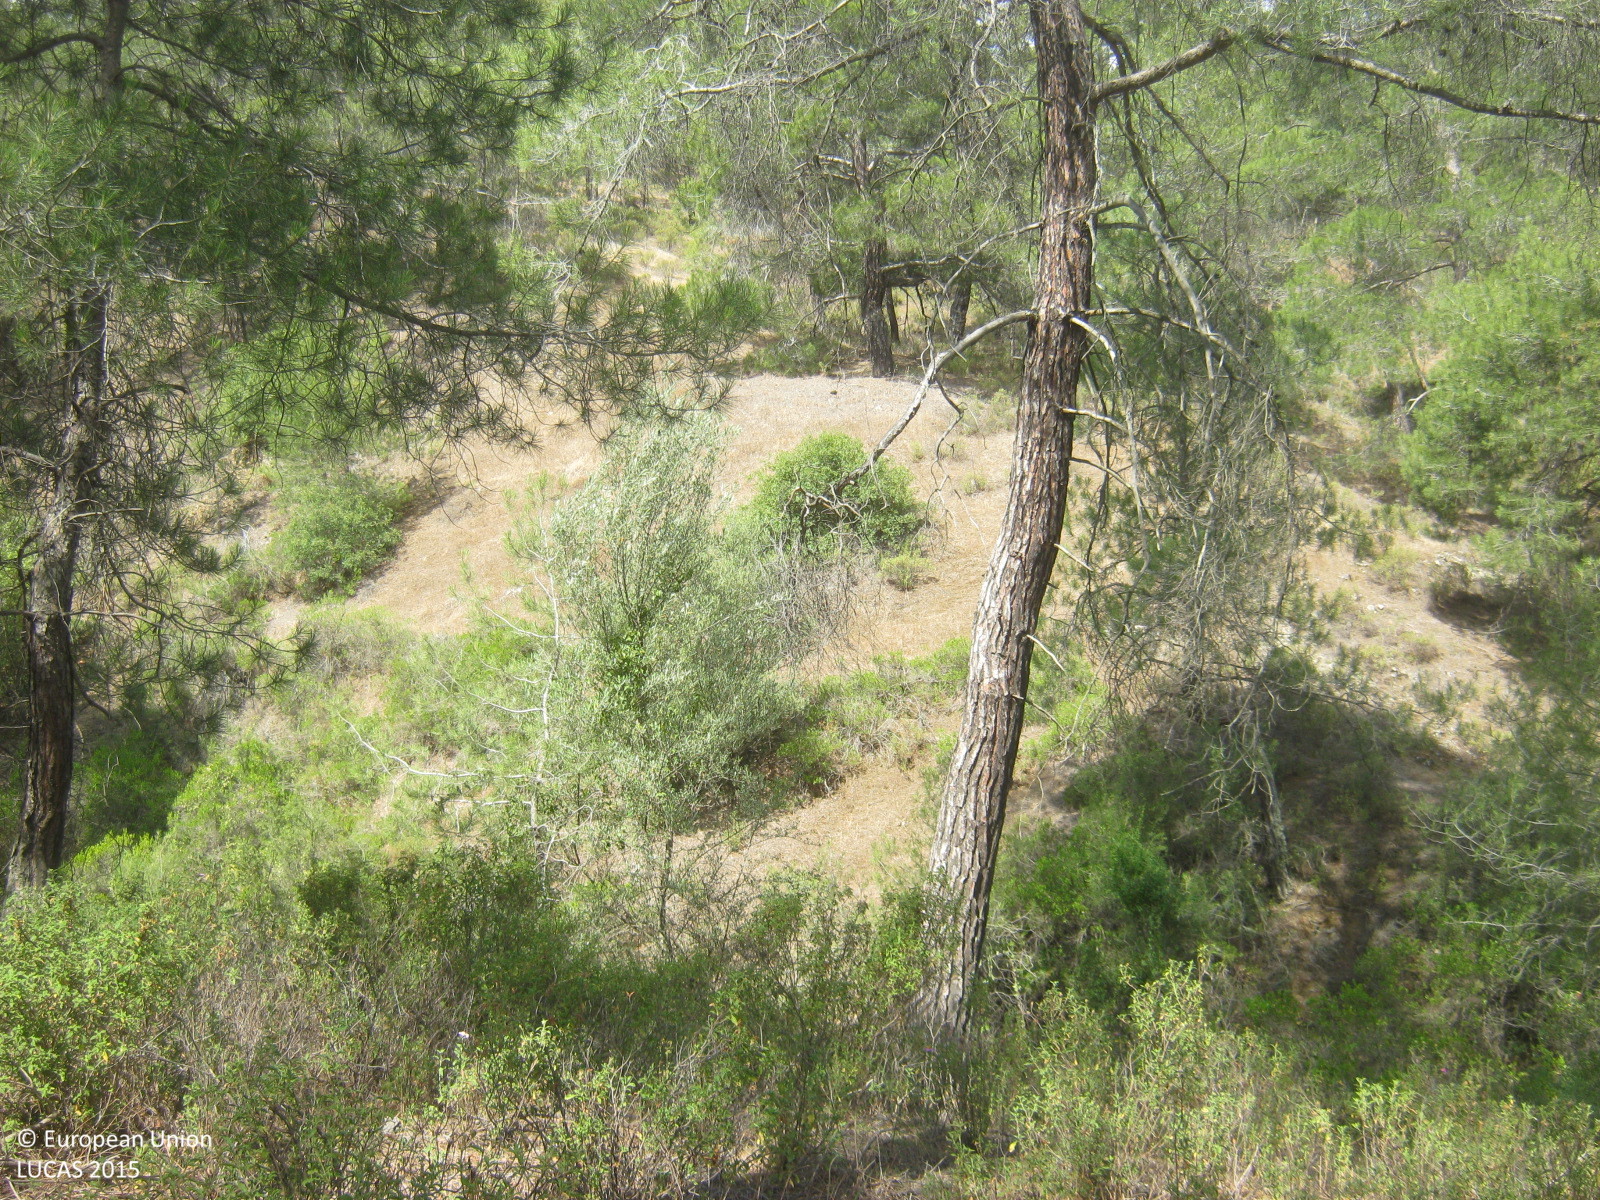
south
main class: Woodland
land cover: Pine dominated coniferous woodland
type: coniferous forest of the mediterranean region
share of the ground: > 75 %
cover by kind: coniferous forest trees 75 %, shrubs 20 %, unconsolidated bare surface 5 %
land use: Forestry
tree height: > 5 m
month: June
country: CY
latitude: 35.0518
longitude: 32.9450
